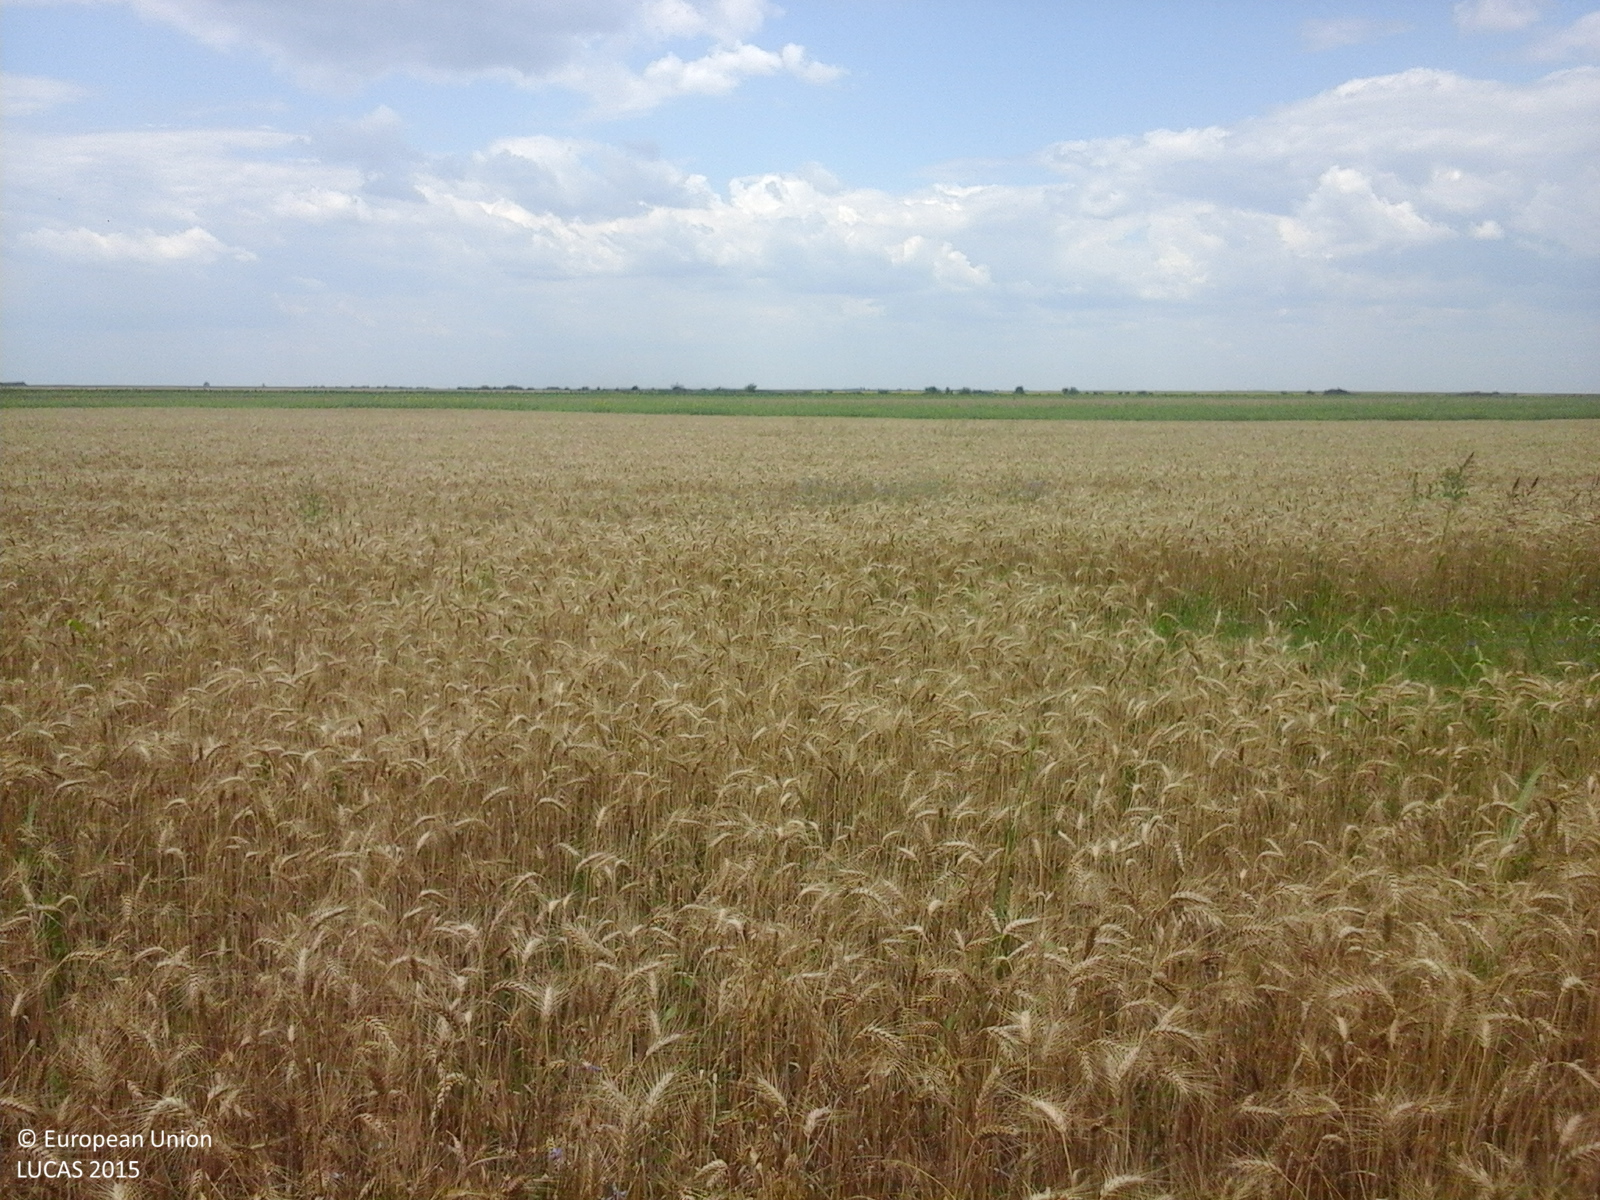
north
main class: Cropland
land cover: Maize
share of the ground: > 75 %
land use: Agriculture (excluding fallow land and kitchen gardens)
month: July
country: RO
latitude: 44.0143
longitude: 24.6769
